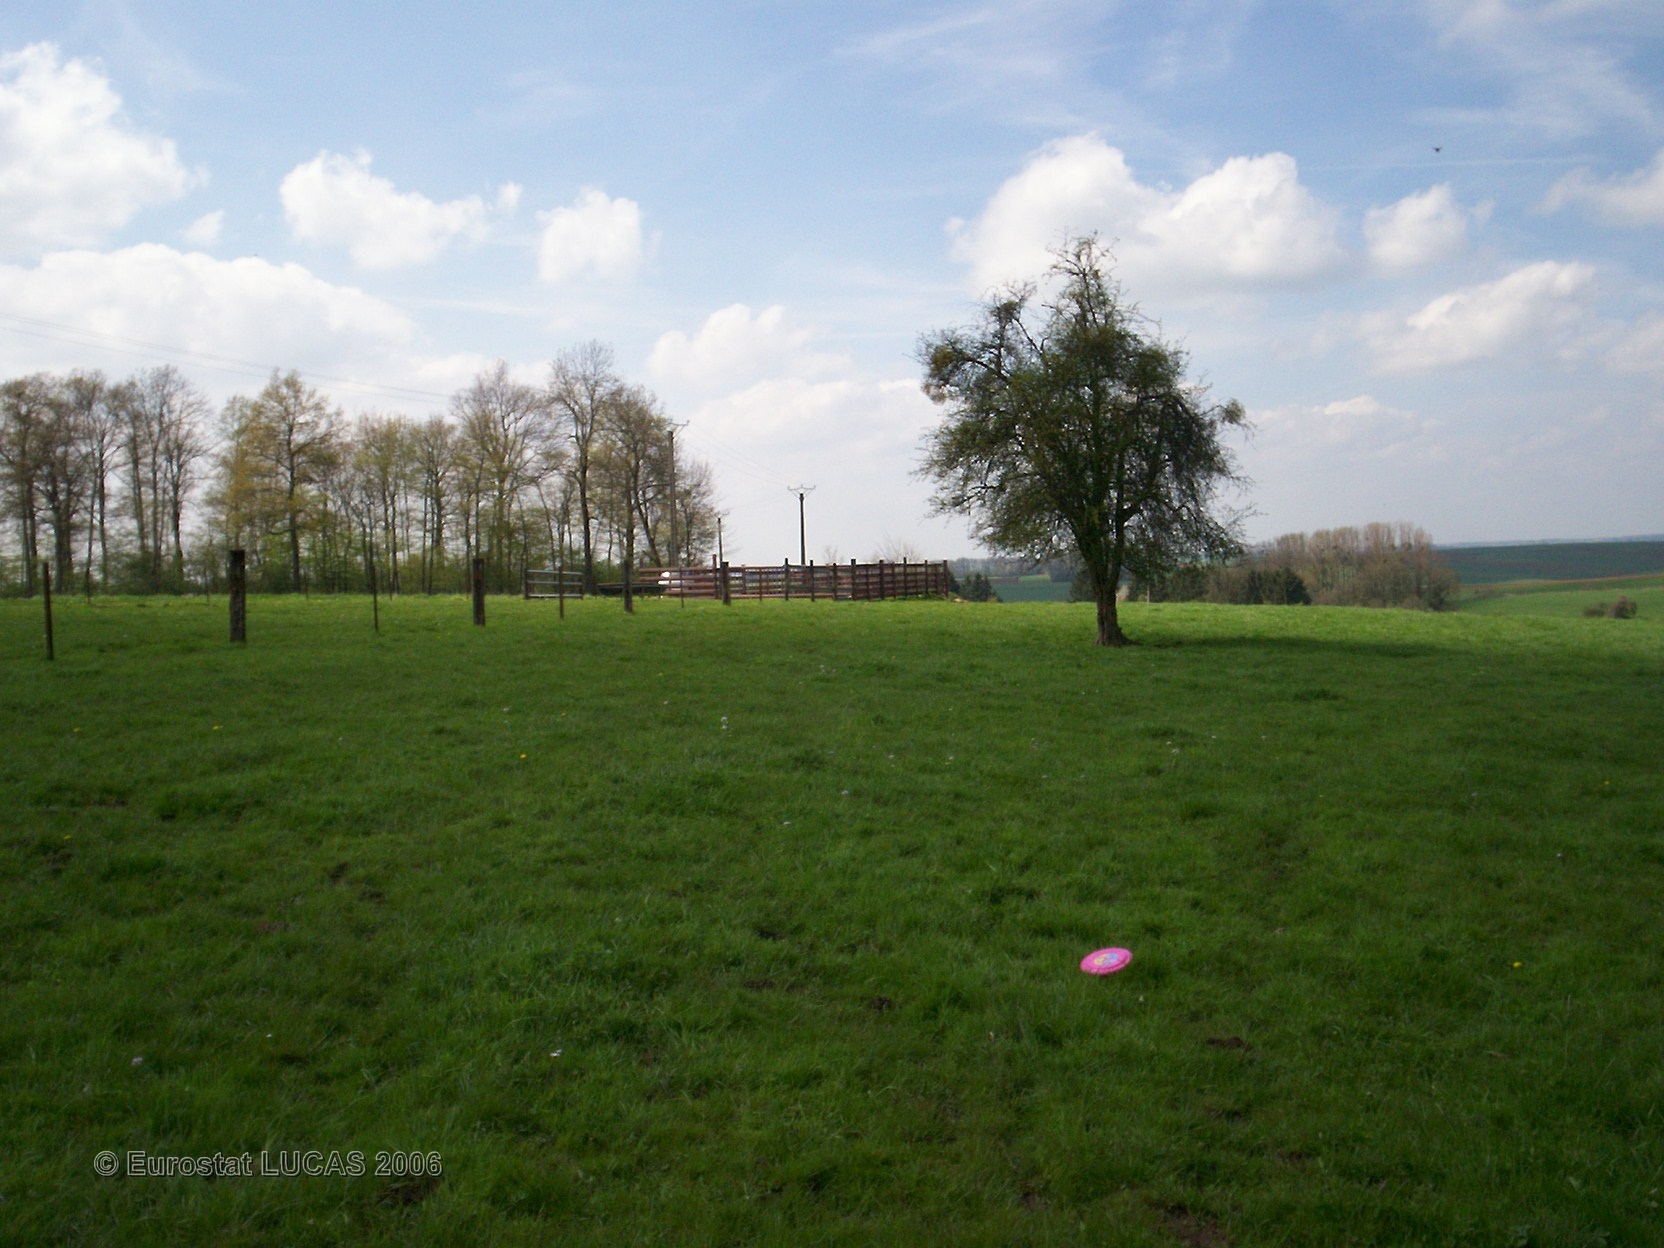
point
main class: Grassland
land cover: Grassland without tree/shrub cover
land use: Agriculture (excluding fallow land and kitchen gardens)
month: May
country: FR
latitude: 49.8286
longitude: 4.3655
